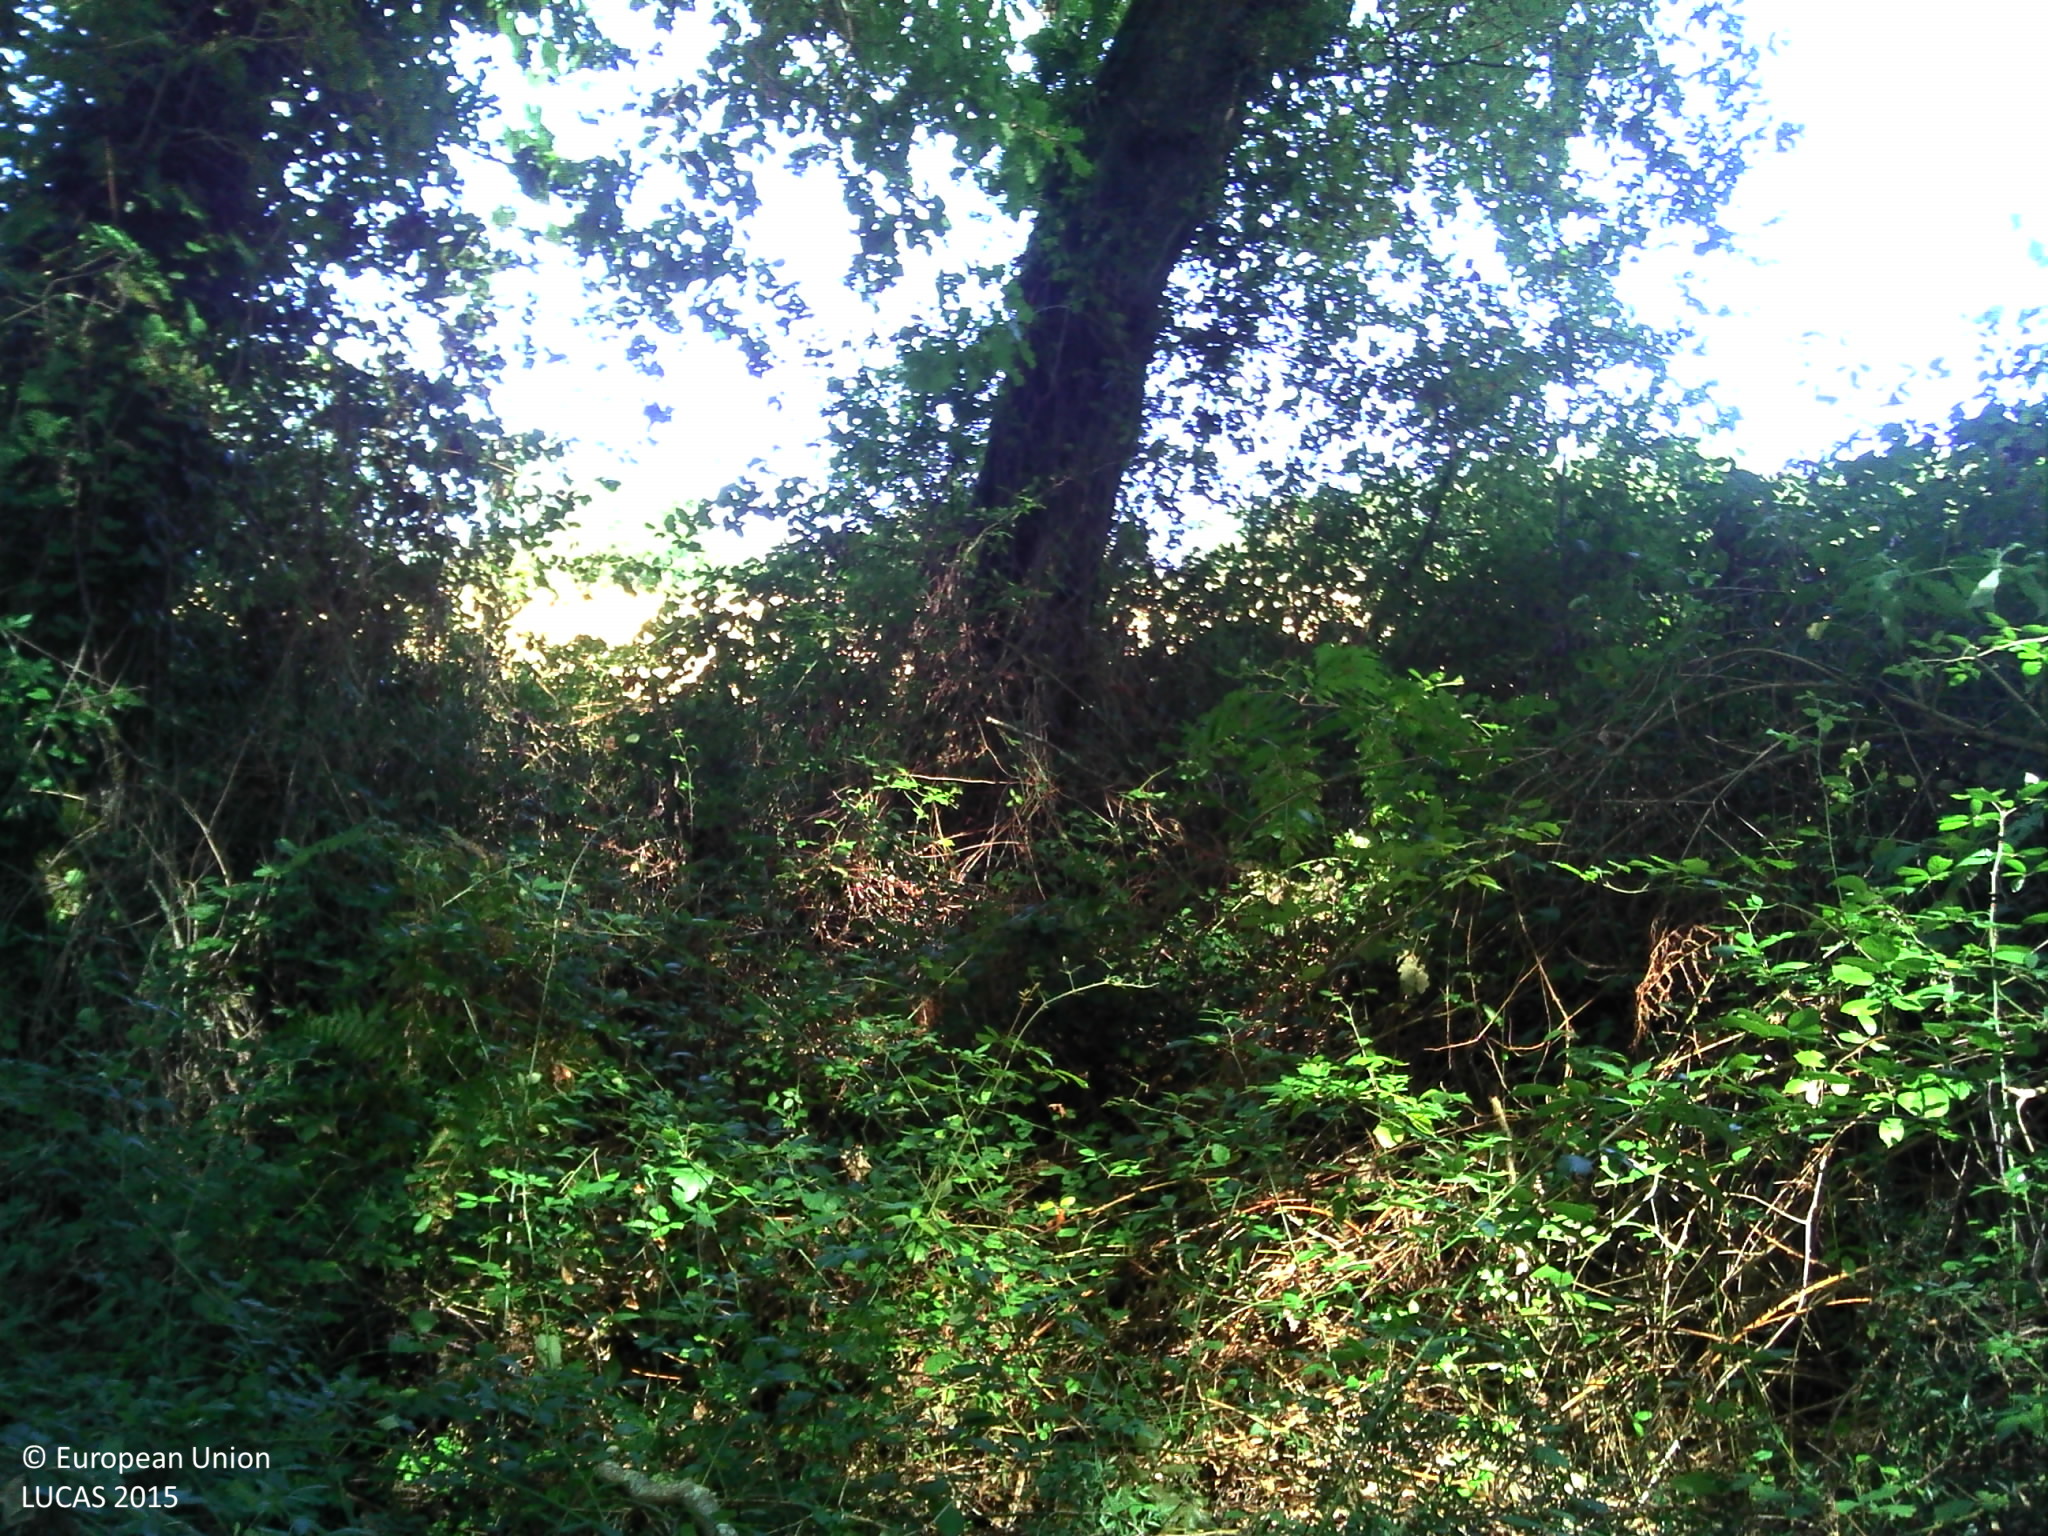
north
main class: Woodland
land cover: Broadleaved woodland
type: acidophilous oak and oak-birch forest
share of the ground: > 75 %
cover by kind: broadleaved forest trees 75 %, shrubs 15 %, herbaceous plants 5 %, lichens and mosses 5 %
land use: Forestry
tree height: > 5 m
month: September
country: FR
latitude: 43.2871
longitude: -0.6945
